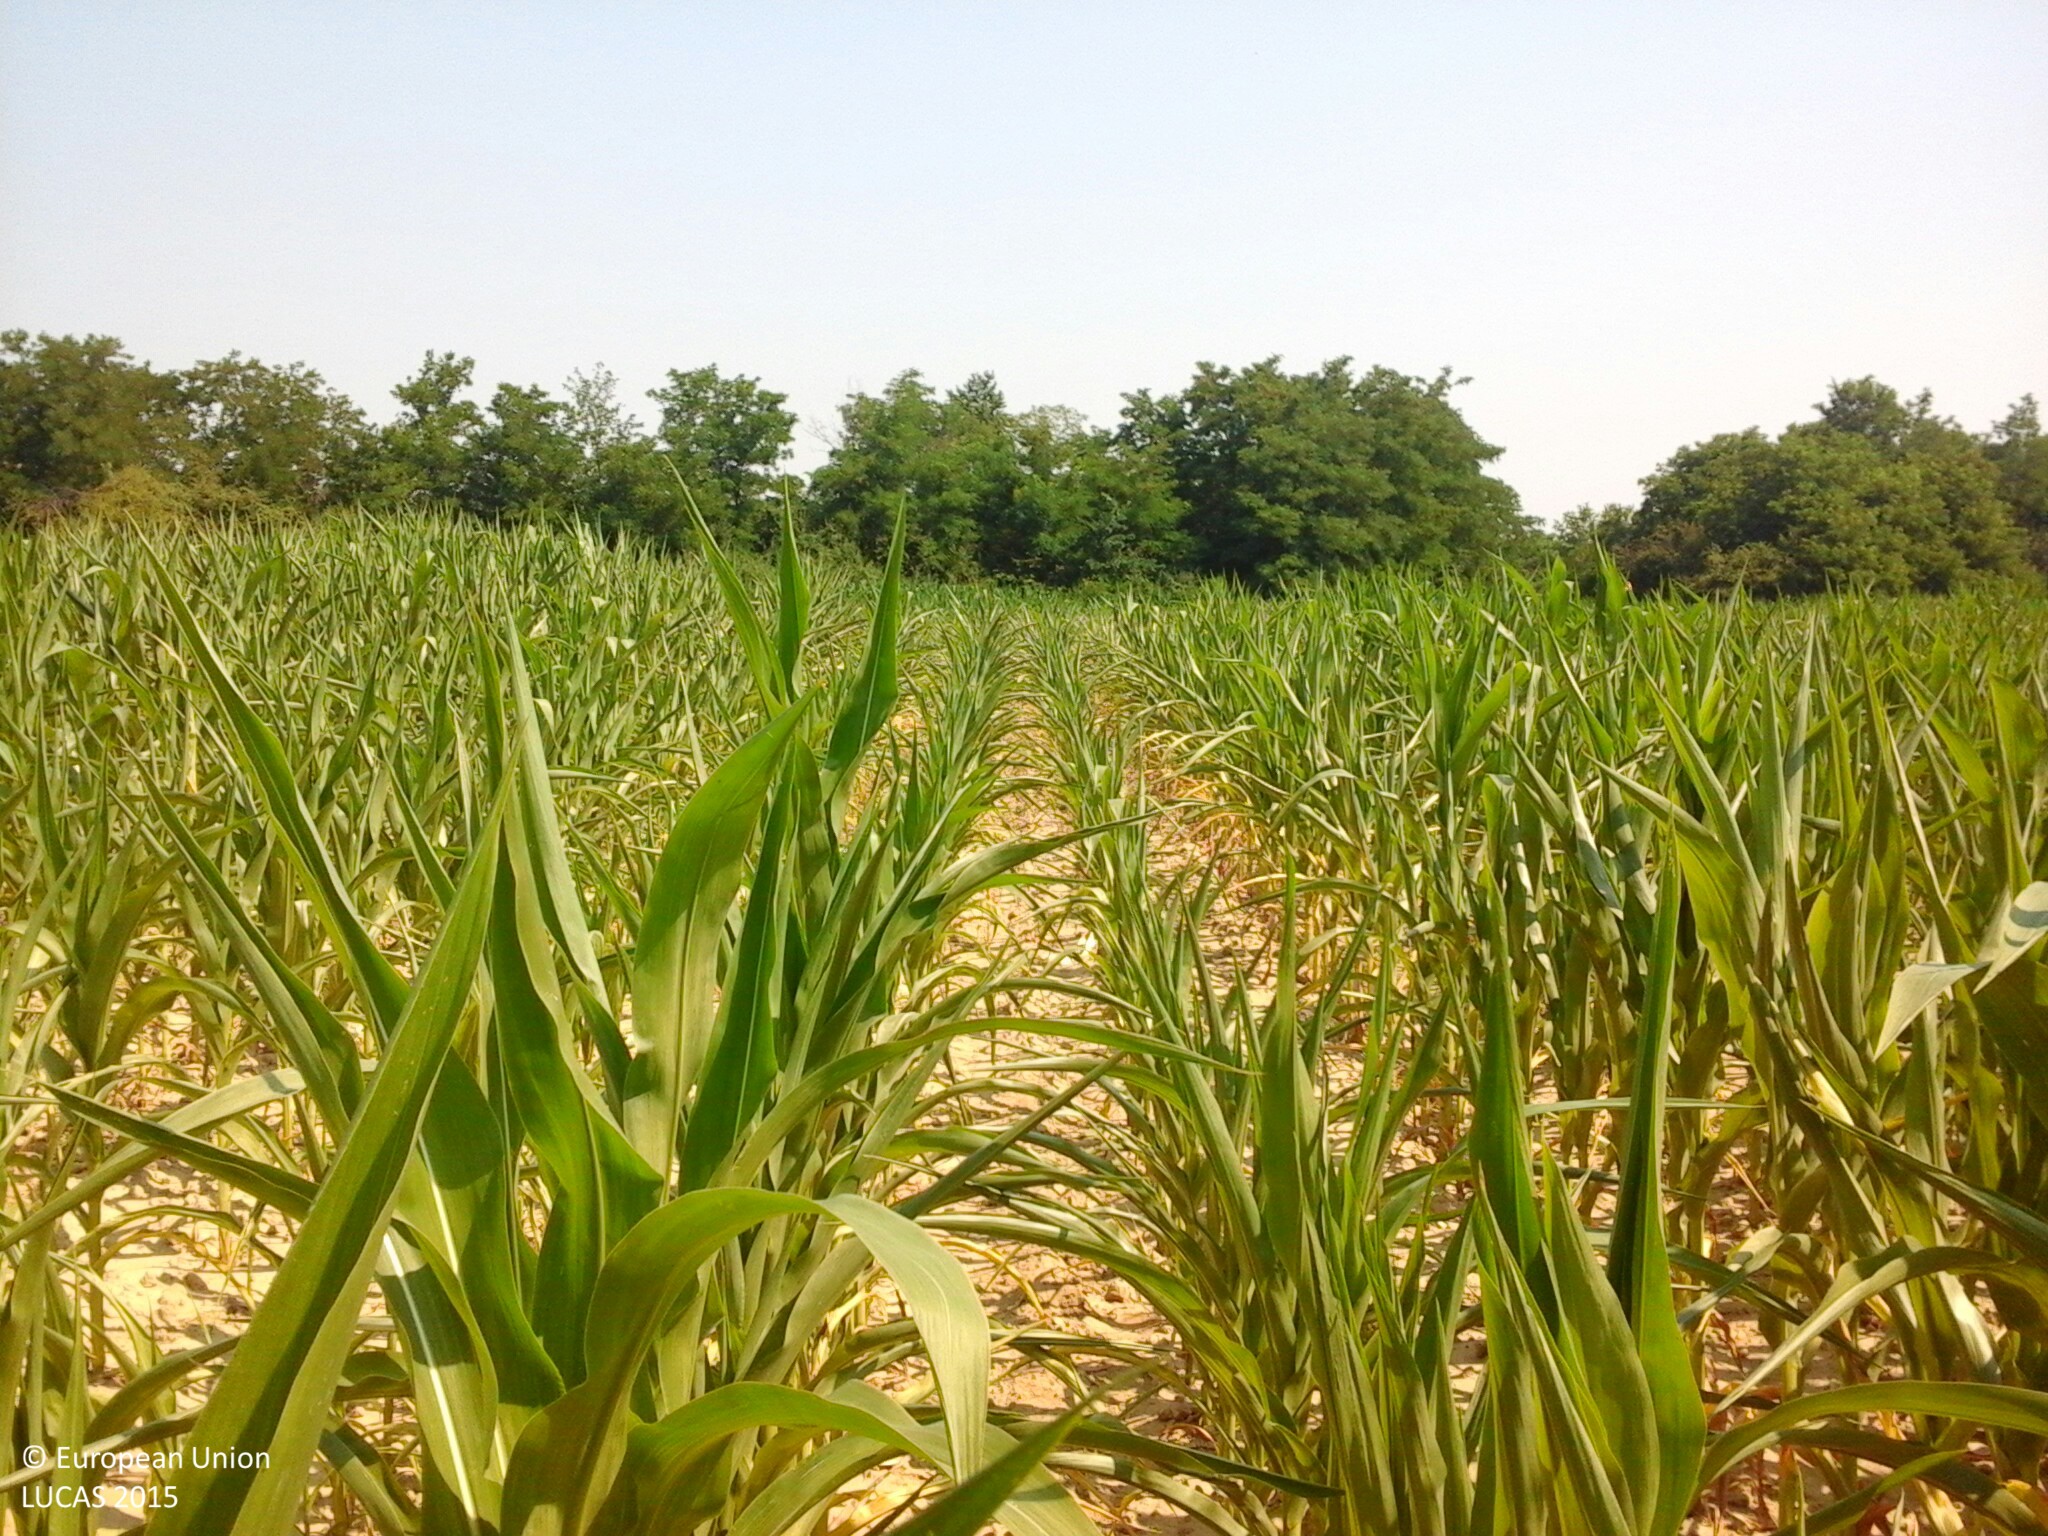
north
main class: Cropland
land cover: Maize
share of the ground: 50 - 75 %
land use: Agriculture (excluding fallow land and kitchen gardens)
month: July
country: HU
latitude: 48.2920
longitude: 22.1732
